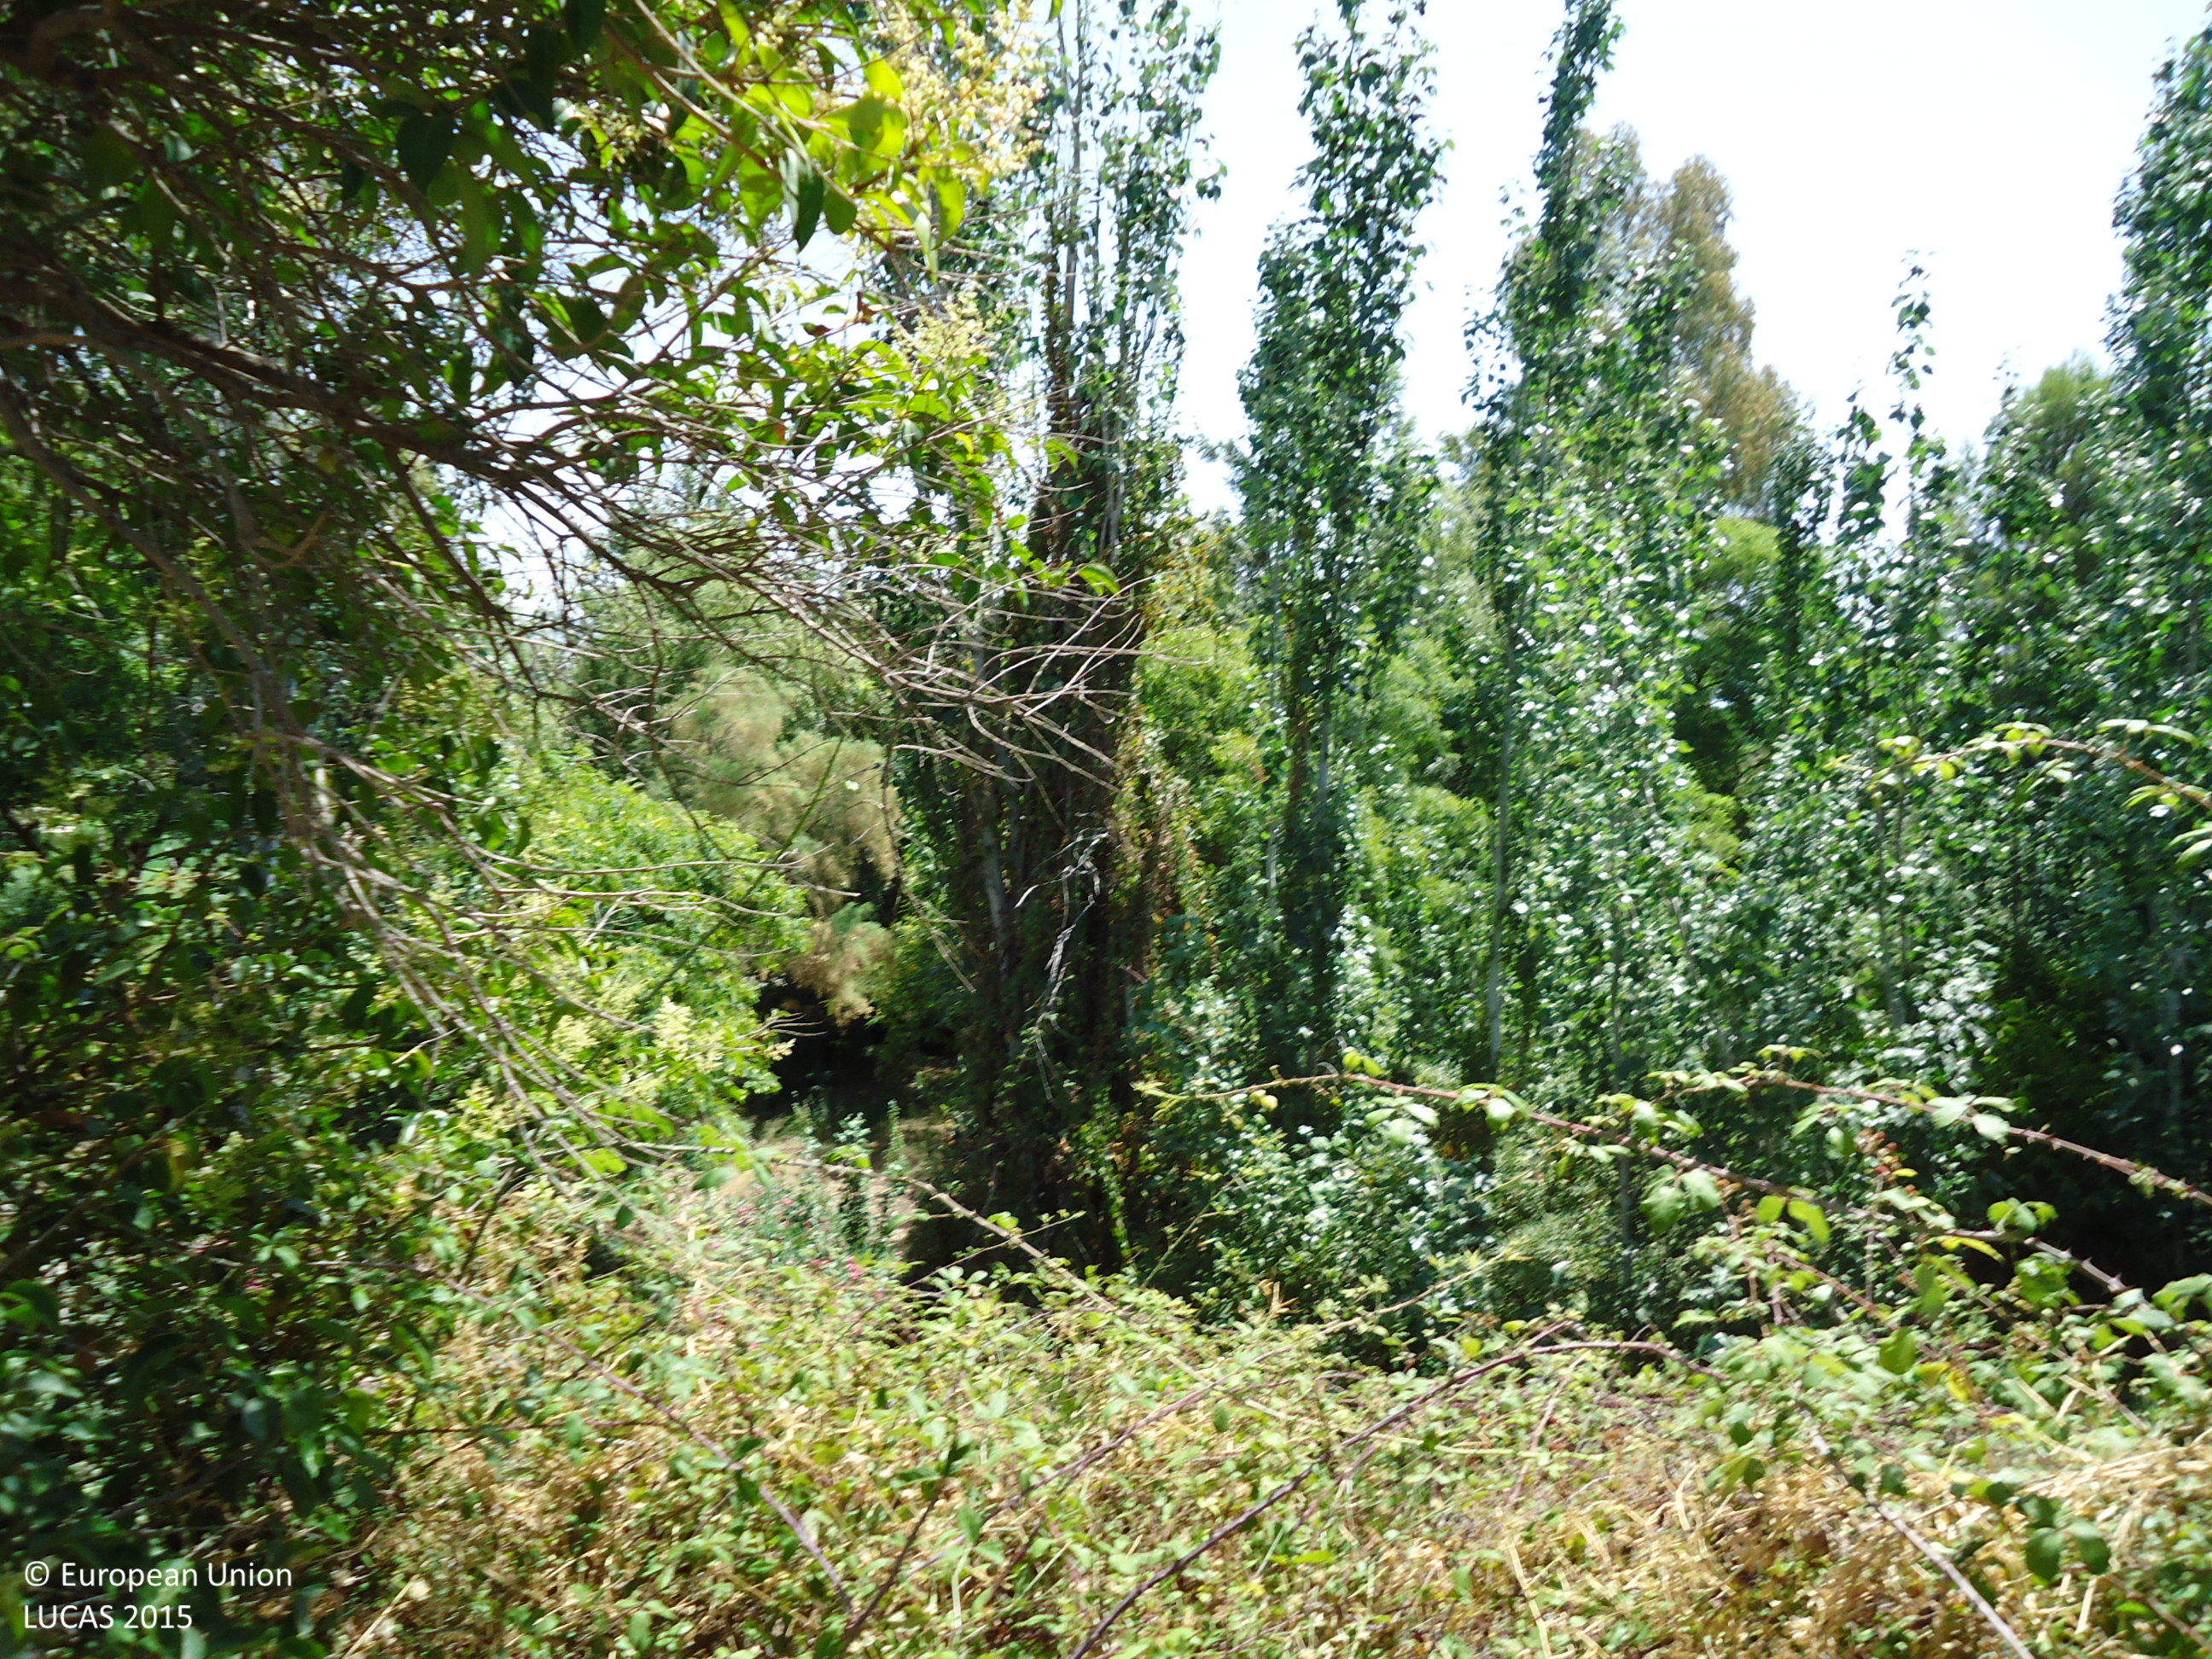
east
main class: Woodland
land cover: Broadleaved woodland
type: non-riverine alder, birch or aspen forest
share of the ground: > 75 %
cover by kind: broadleaved forest trees 95 %, shrubs 5 %
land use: Sport
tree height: > 5 m
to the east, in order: Broadleaved woodland; Grassland without tree/shrub cover; Tracks; Grassland without tree/shrub cover; Shrubland with sparse tree cover; Tracks; Shrubland with sparse tree cover
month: July
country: ES
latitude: 36.5395
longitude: -4.7232
